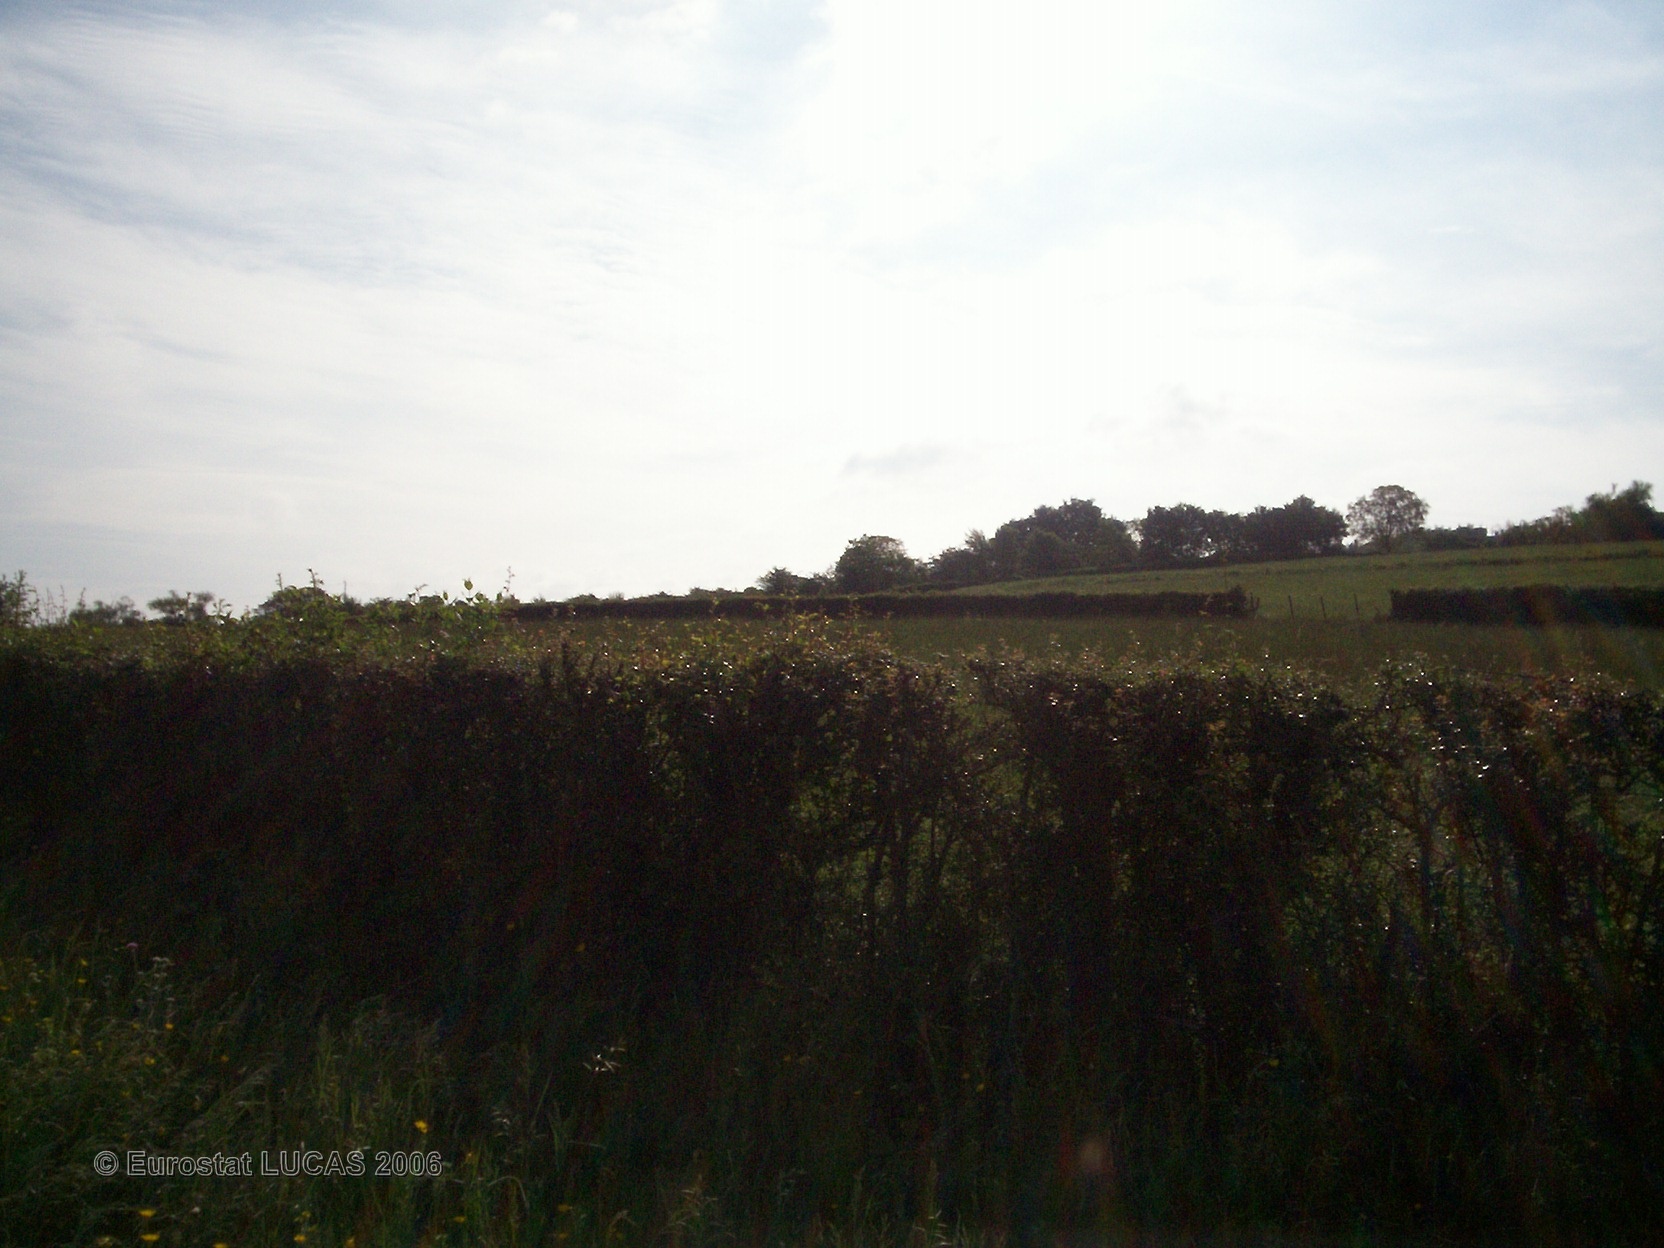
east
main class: Grassland
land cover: Grassland without tree/shrub cover
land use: Agriculture (excluding fallow land and kitchen gardens)
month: May
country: FR
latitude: 46.7406
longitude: 4.6480
